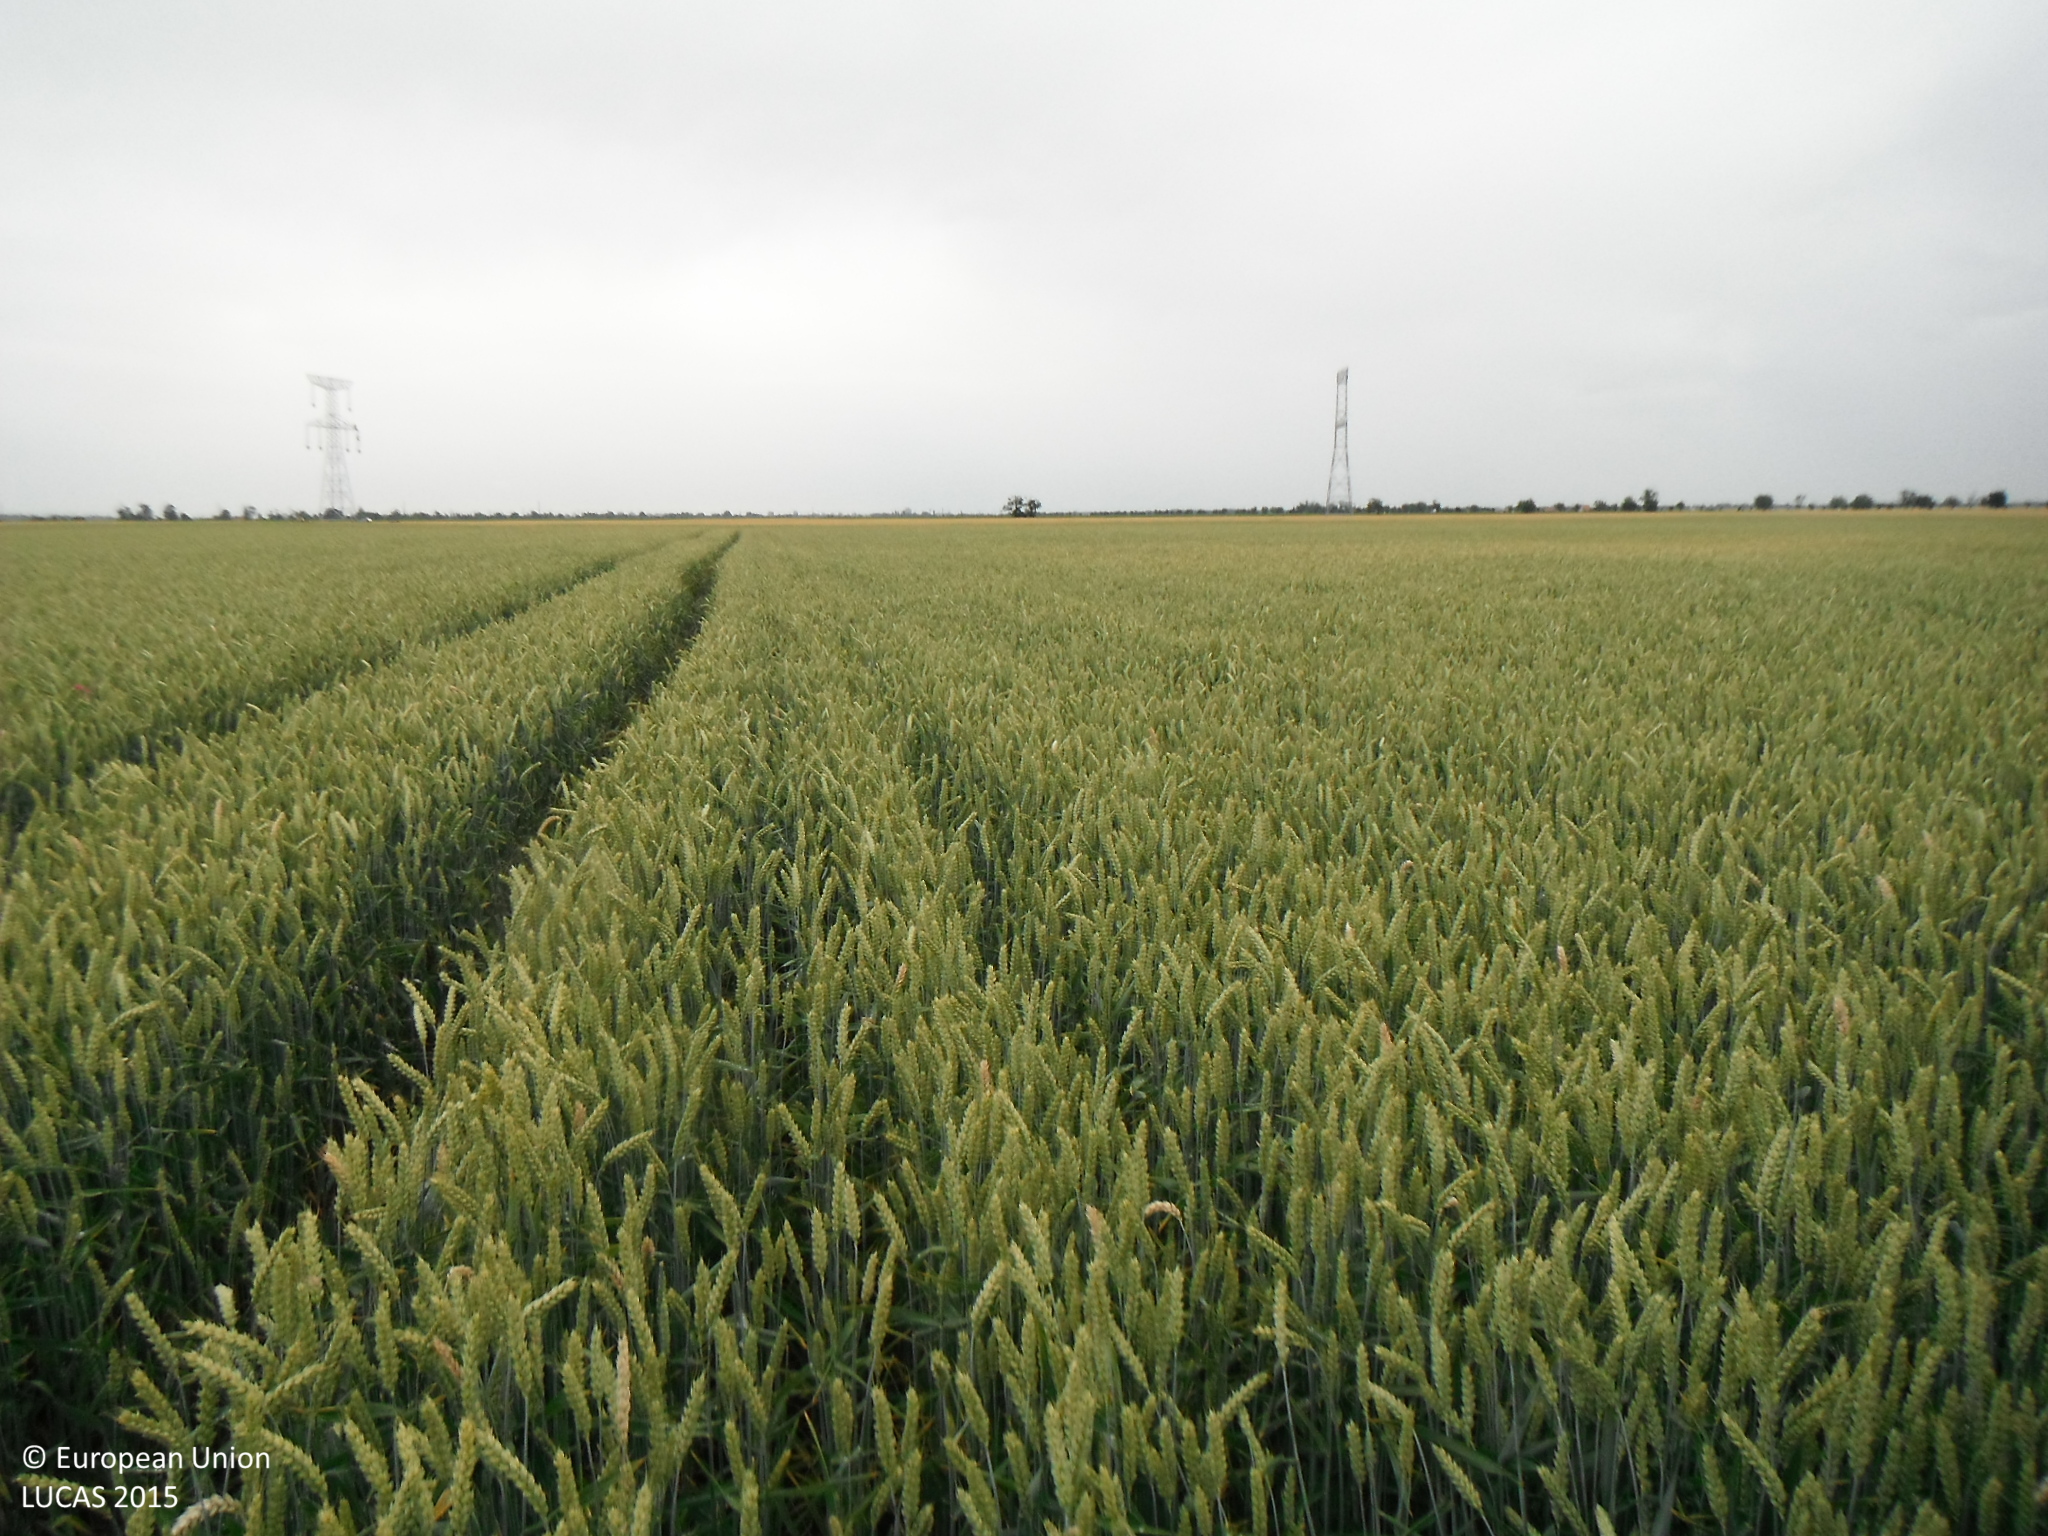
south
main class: Cropland
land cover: Common wheat
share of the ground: > 75 %
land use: Agriculture (excluding fallow land and kitchen gardens)
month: June
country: SK
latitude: 48.0654
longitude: 18.1591
